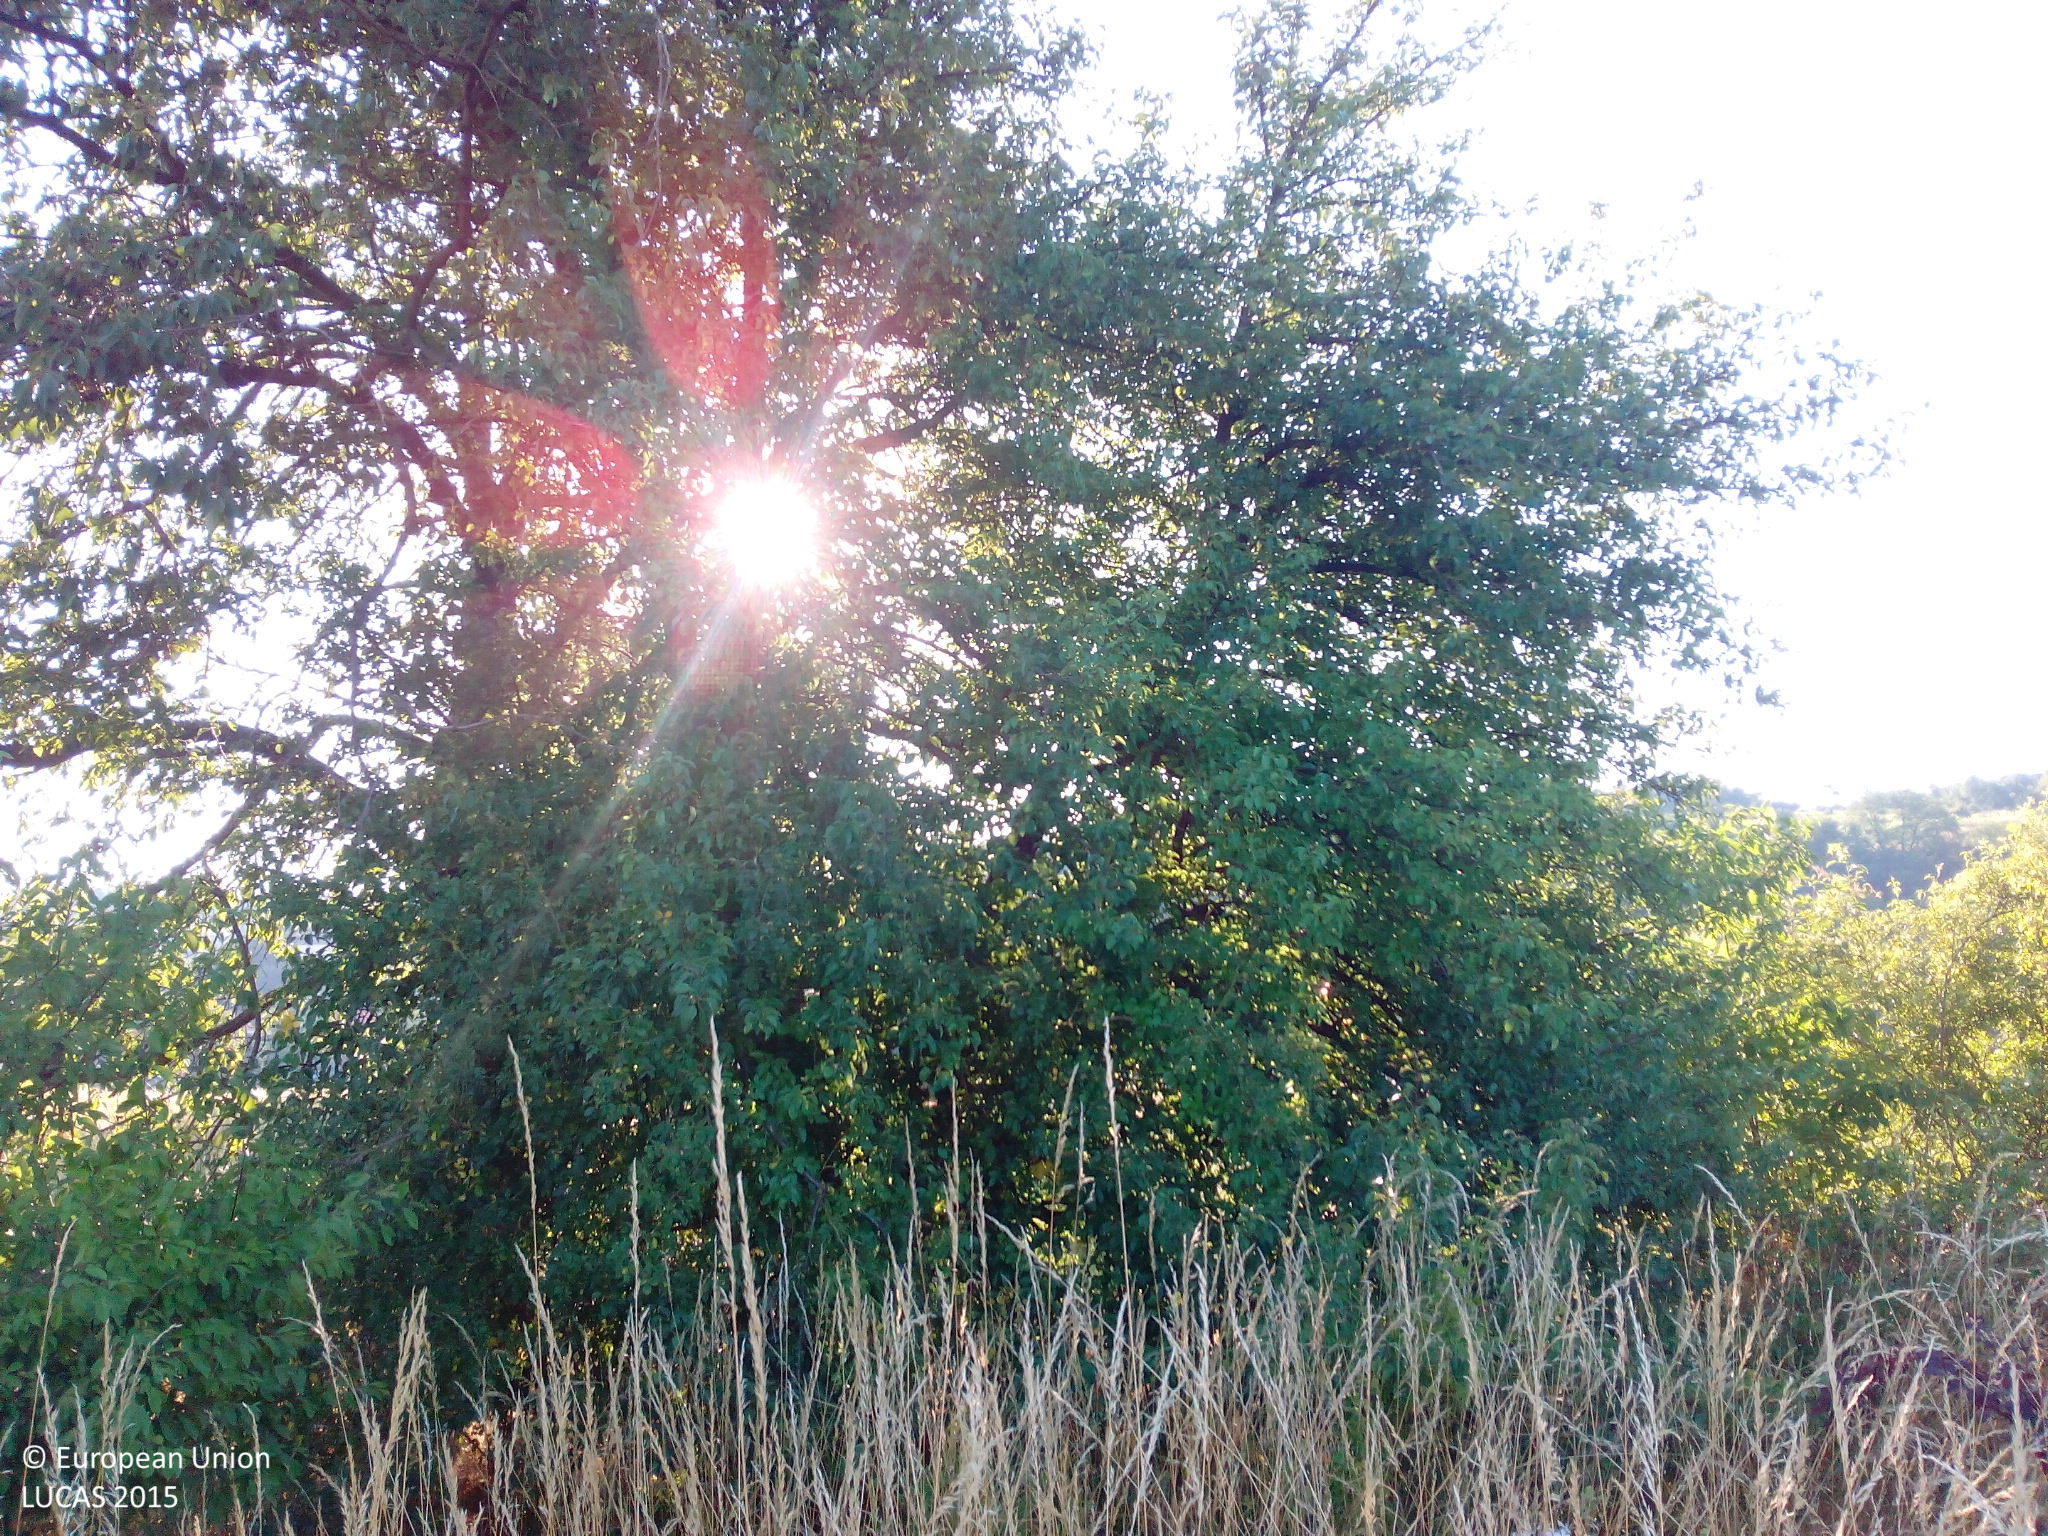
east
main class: Shrubland
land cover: Shrubland with sparse tree cover
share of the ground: > 75 %
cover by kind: shrubs 70 %, herbaceous plants 25 %, broadleaved forest trees 5 %
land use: Agriculture (excluding fallow land and kitchen gardens)
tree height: > 5 m
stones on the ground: < 10 %
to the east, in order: Shrubland with sparse tree cover; Broadleaved woodland; Grassland with sparse tree/shrub cover; Grassland without tree/shrub cover; Inland fresh running water; Grassland without tree/shrub cover
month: July
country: DE
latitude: 51.2306
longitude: 13.4231
